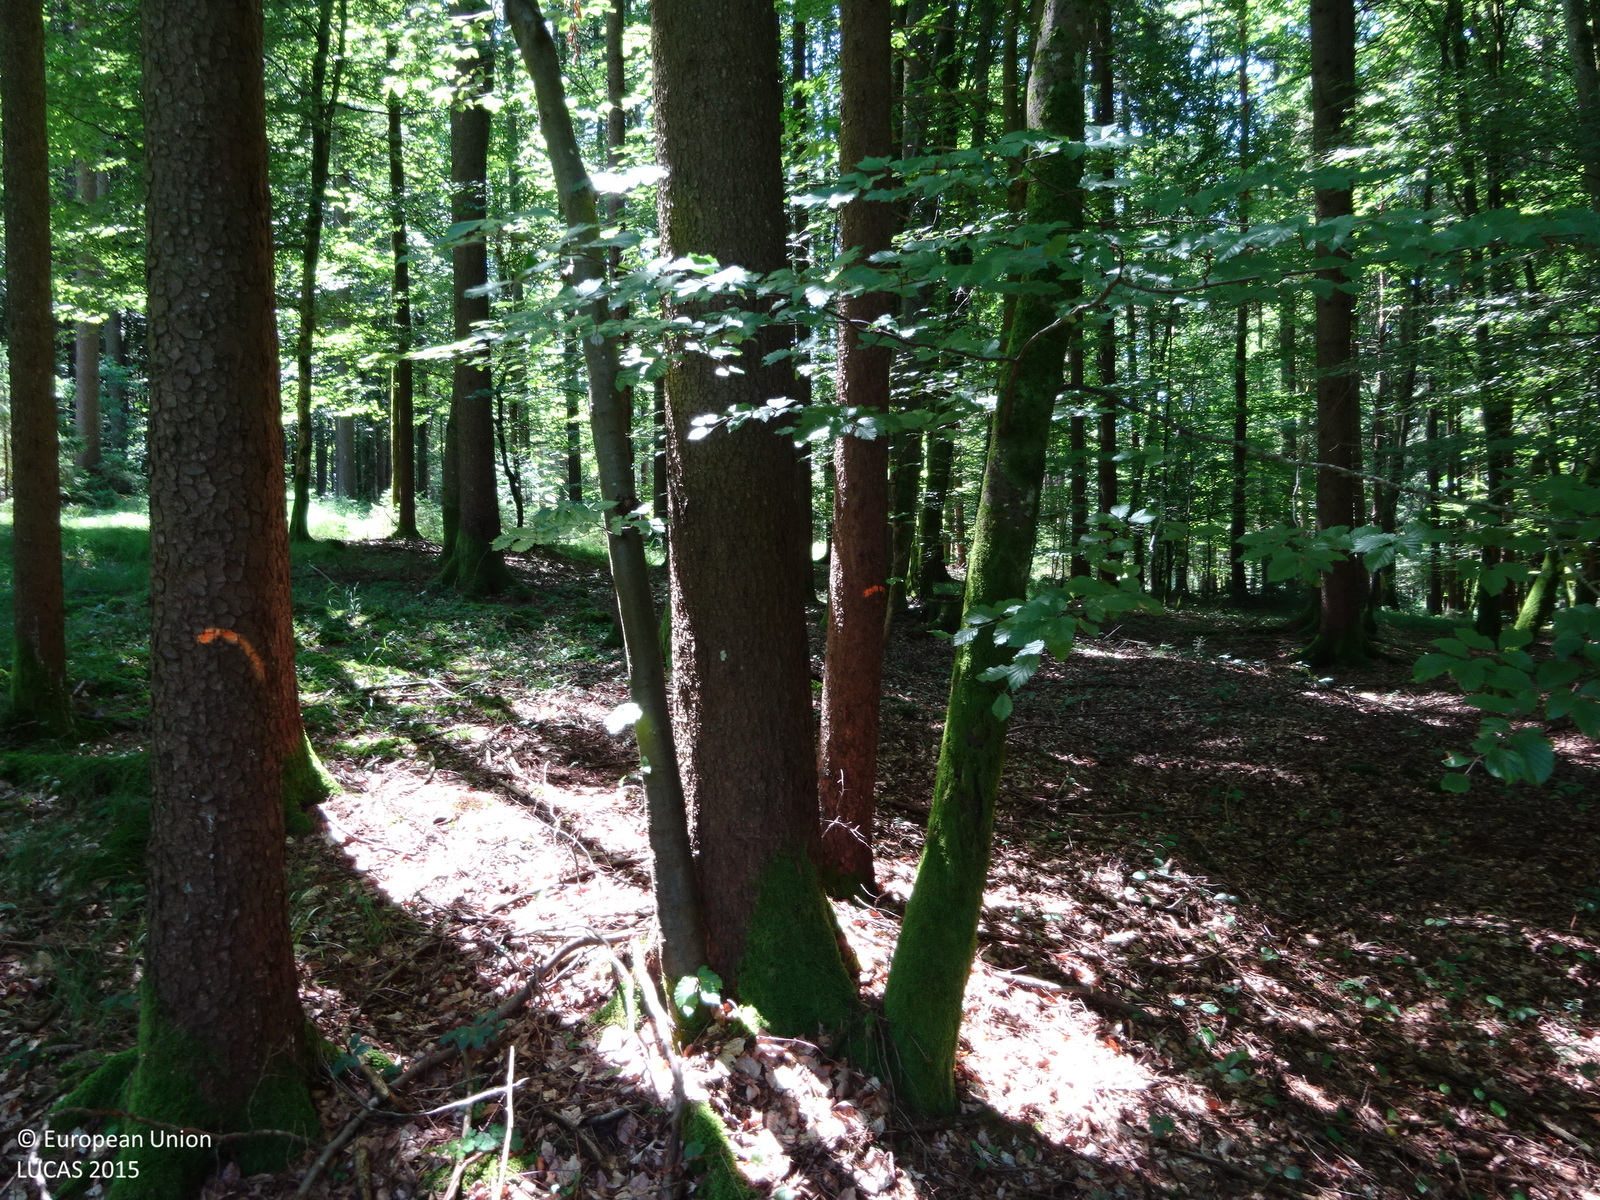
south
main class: Woodland
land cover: Spruce dominated mixed woodland
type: mountainous beech forest
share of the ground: > 75 %
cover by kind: broadleaved forest trees 60 %, coniferous forest trees 30 %, herbaceous plants 5 %, lichens and mosses 5 %
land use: Forestry
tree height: > 5 m
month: July
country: AT
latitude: 46.8869
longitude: 15.3142
